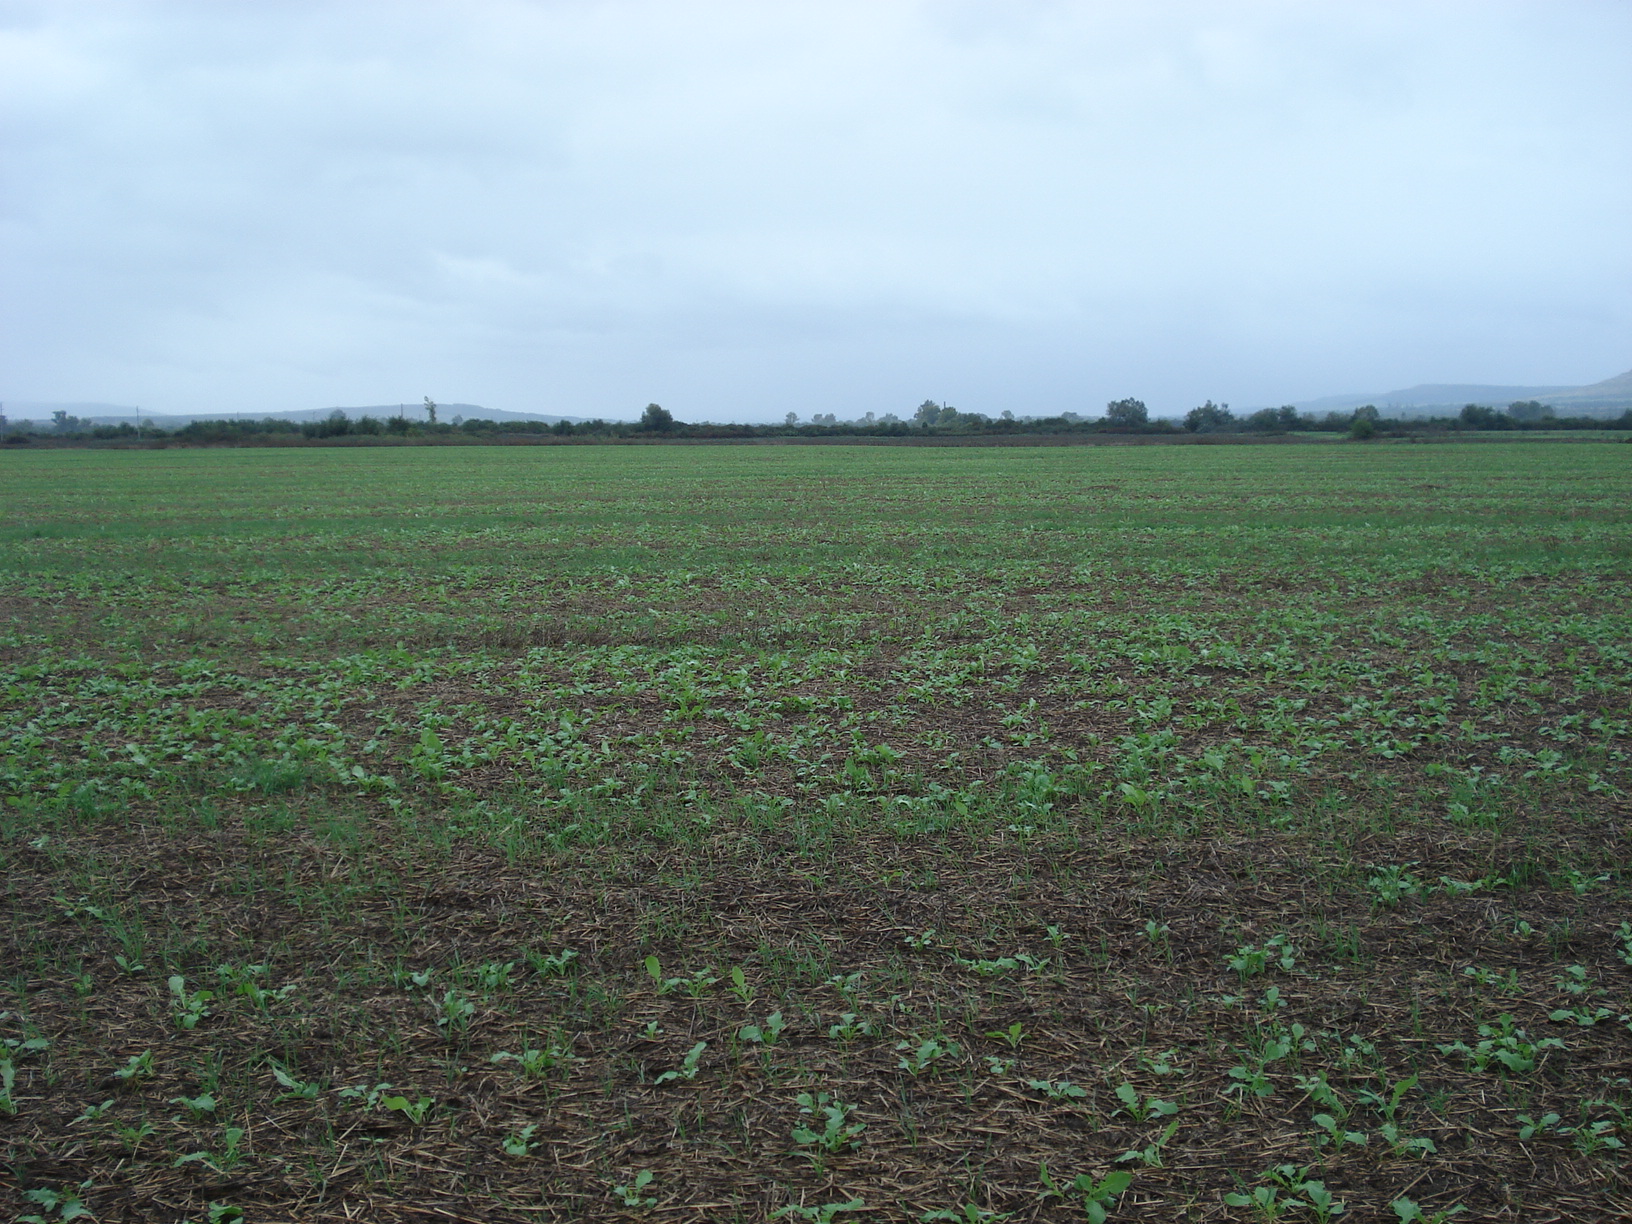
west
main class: Cropland
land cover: Common wheat
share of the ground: 10 - 25 %
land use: Agriculture (excluding fallow land and kitchen gardens)
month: September
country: BG
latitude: 43.1961
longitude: 25.4975
